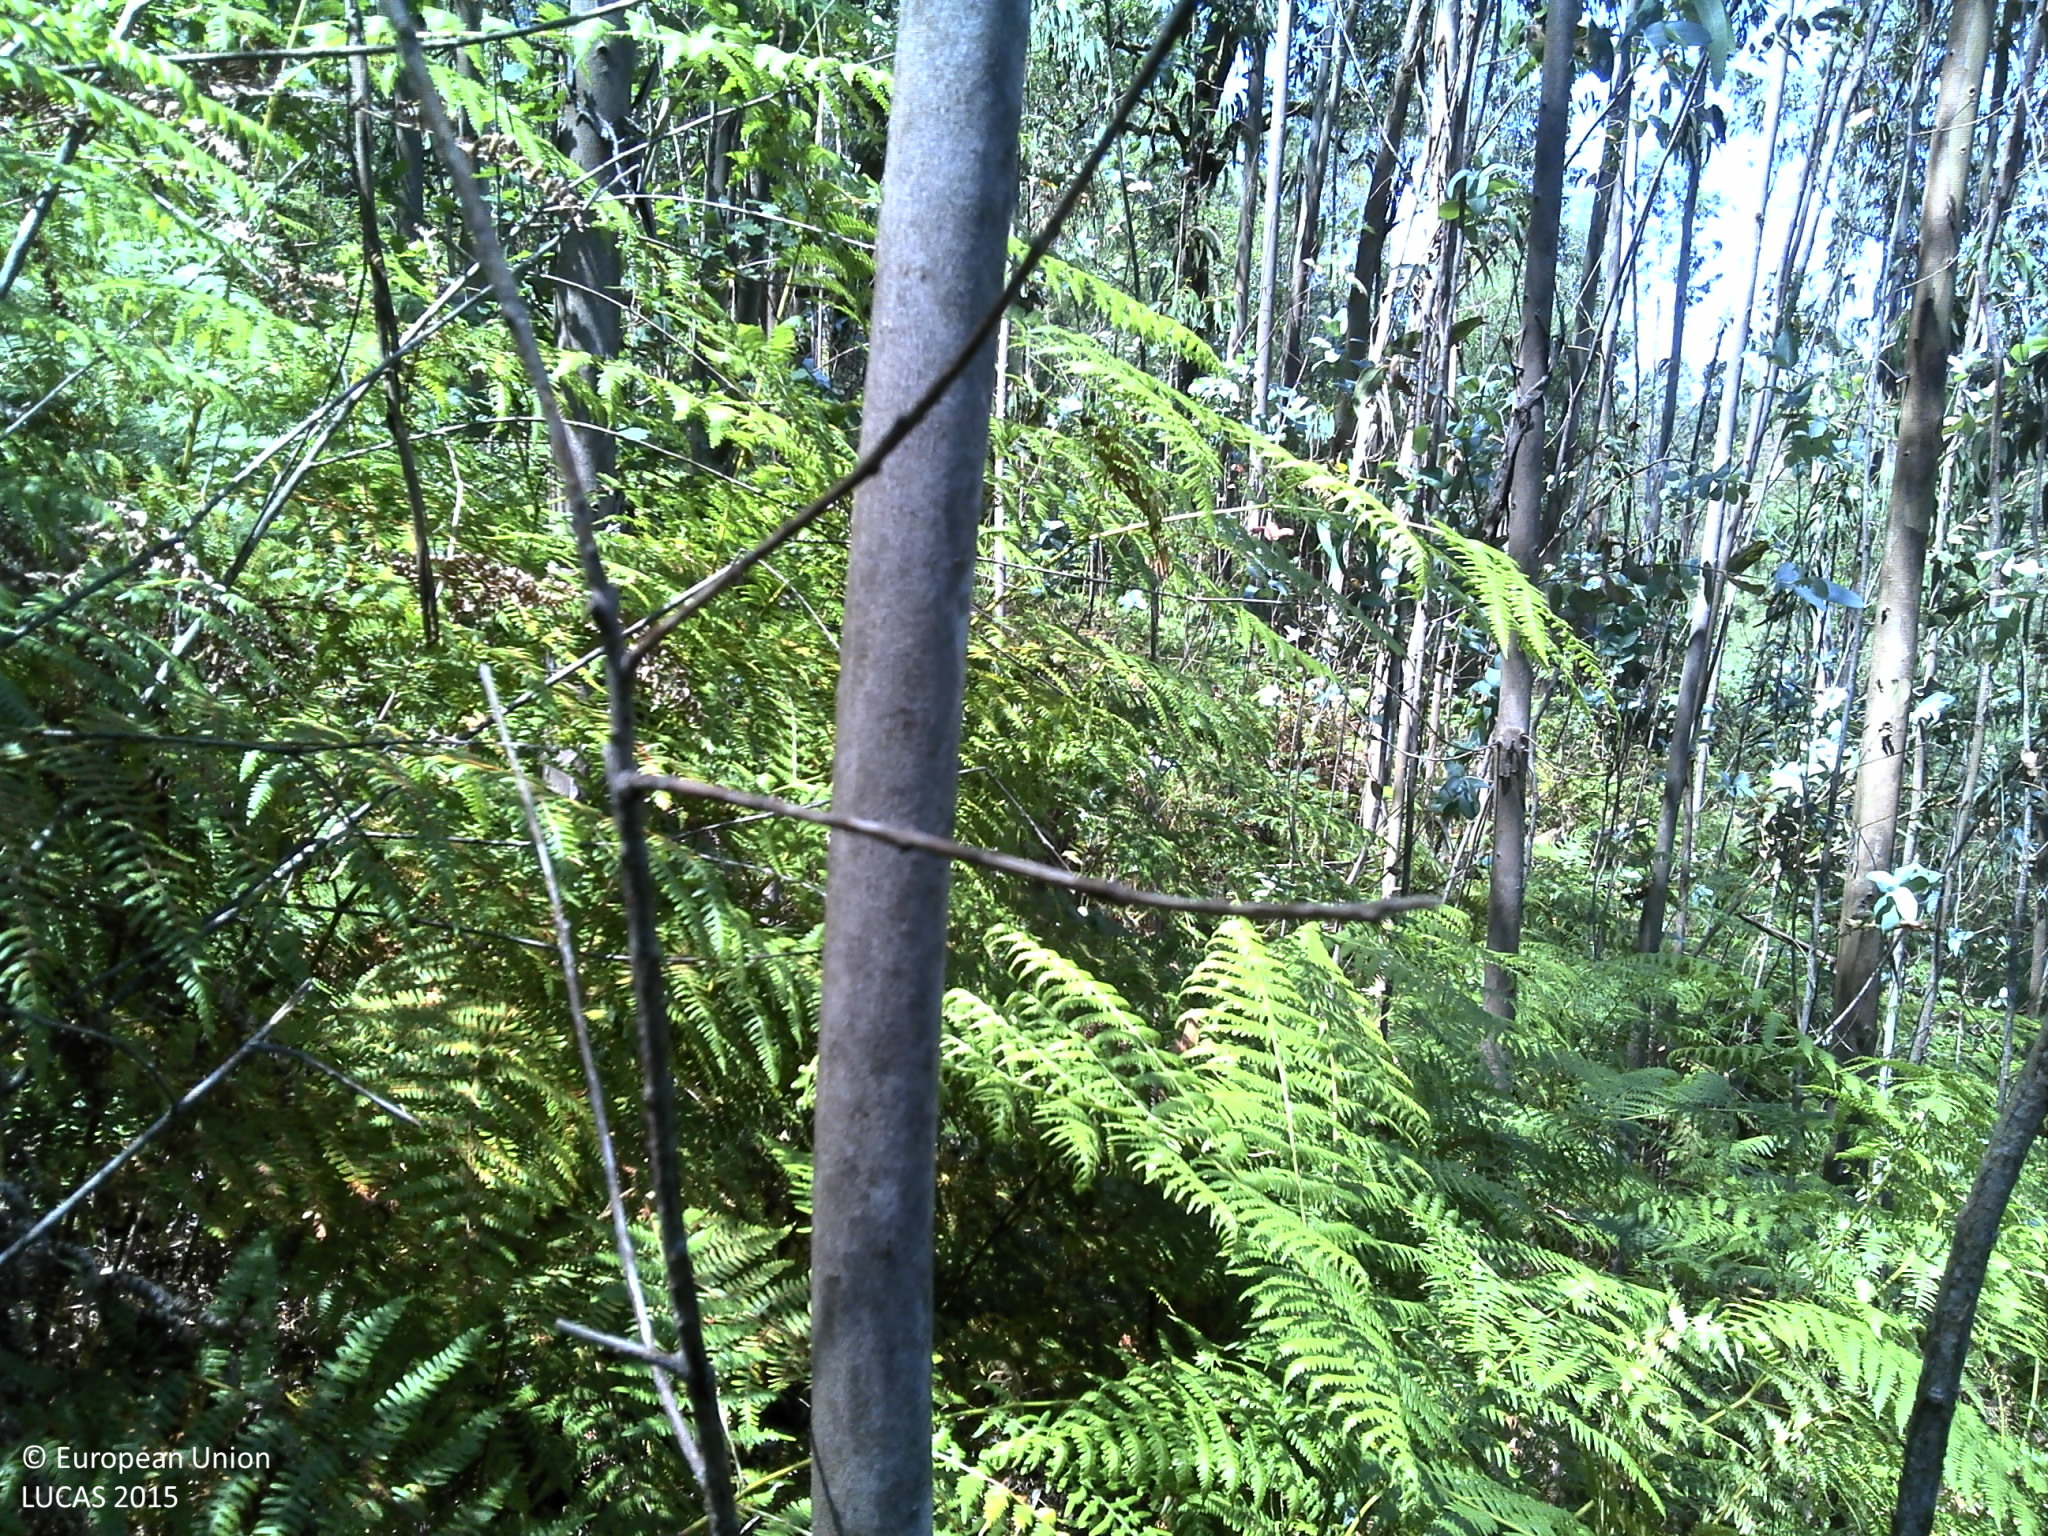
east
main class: Woodland
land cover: Broadleaved woodland
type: exotic forest
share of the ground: 50 - 75 %
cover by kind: broadleaved forest trees 60 %, shrubs 40 %
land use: Forestry
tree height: > 5 m
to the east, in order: Broadleaved woodland; Paved roads, cycling and walking lanes; Broadleaved woodland; Electric lines; Broadleaved woodland; Tracks; Pine dominated coniferous woodland; Tracks; Pine dominated coniferous woodland
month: May
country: PT
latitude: 41.8284
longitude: -8.6473
